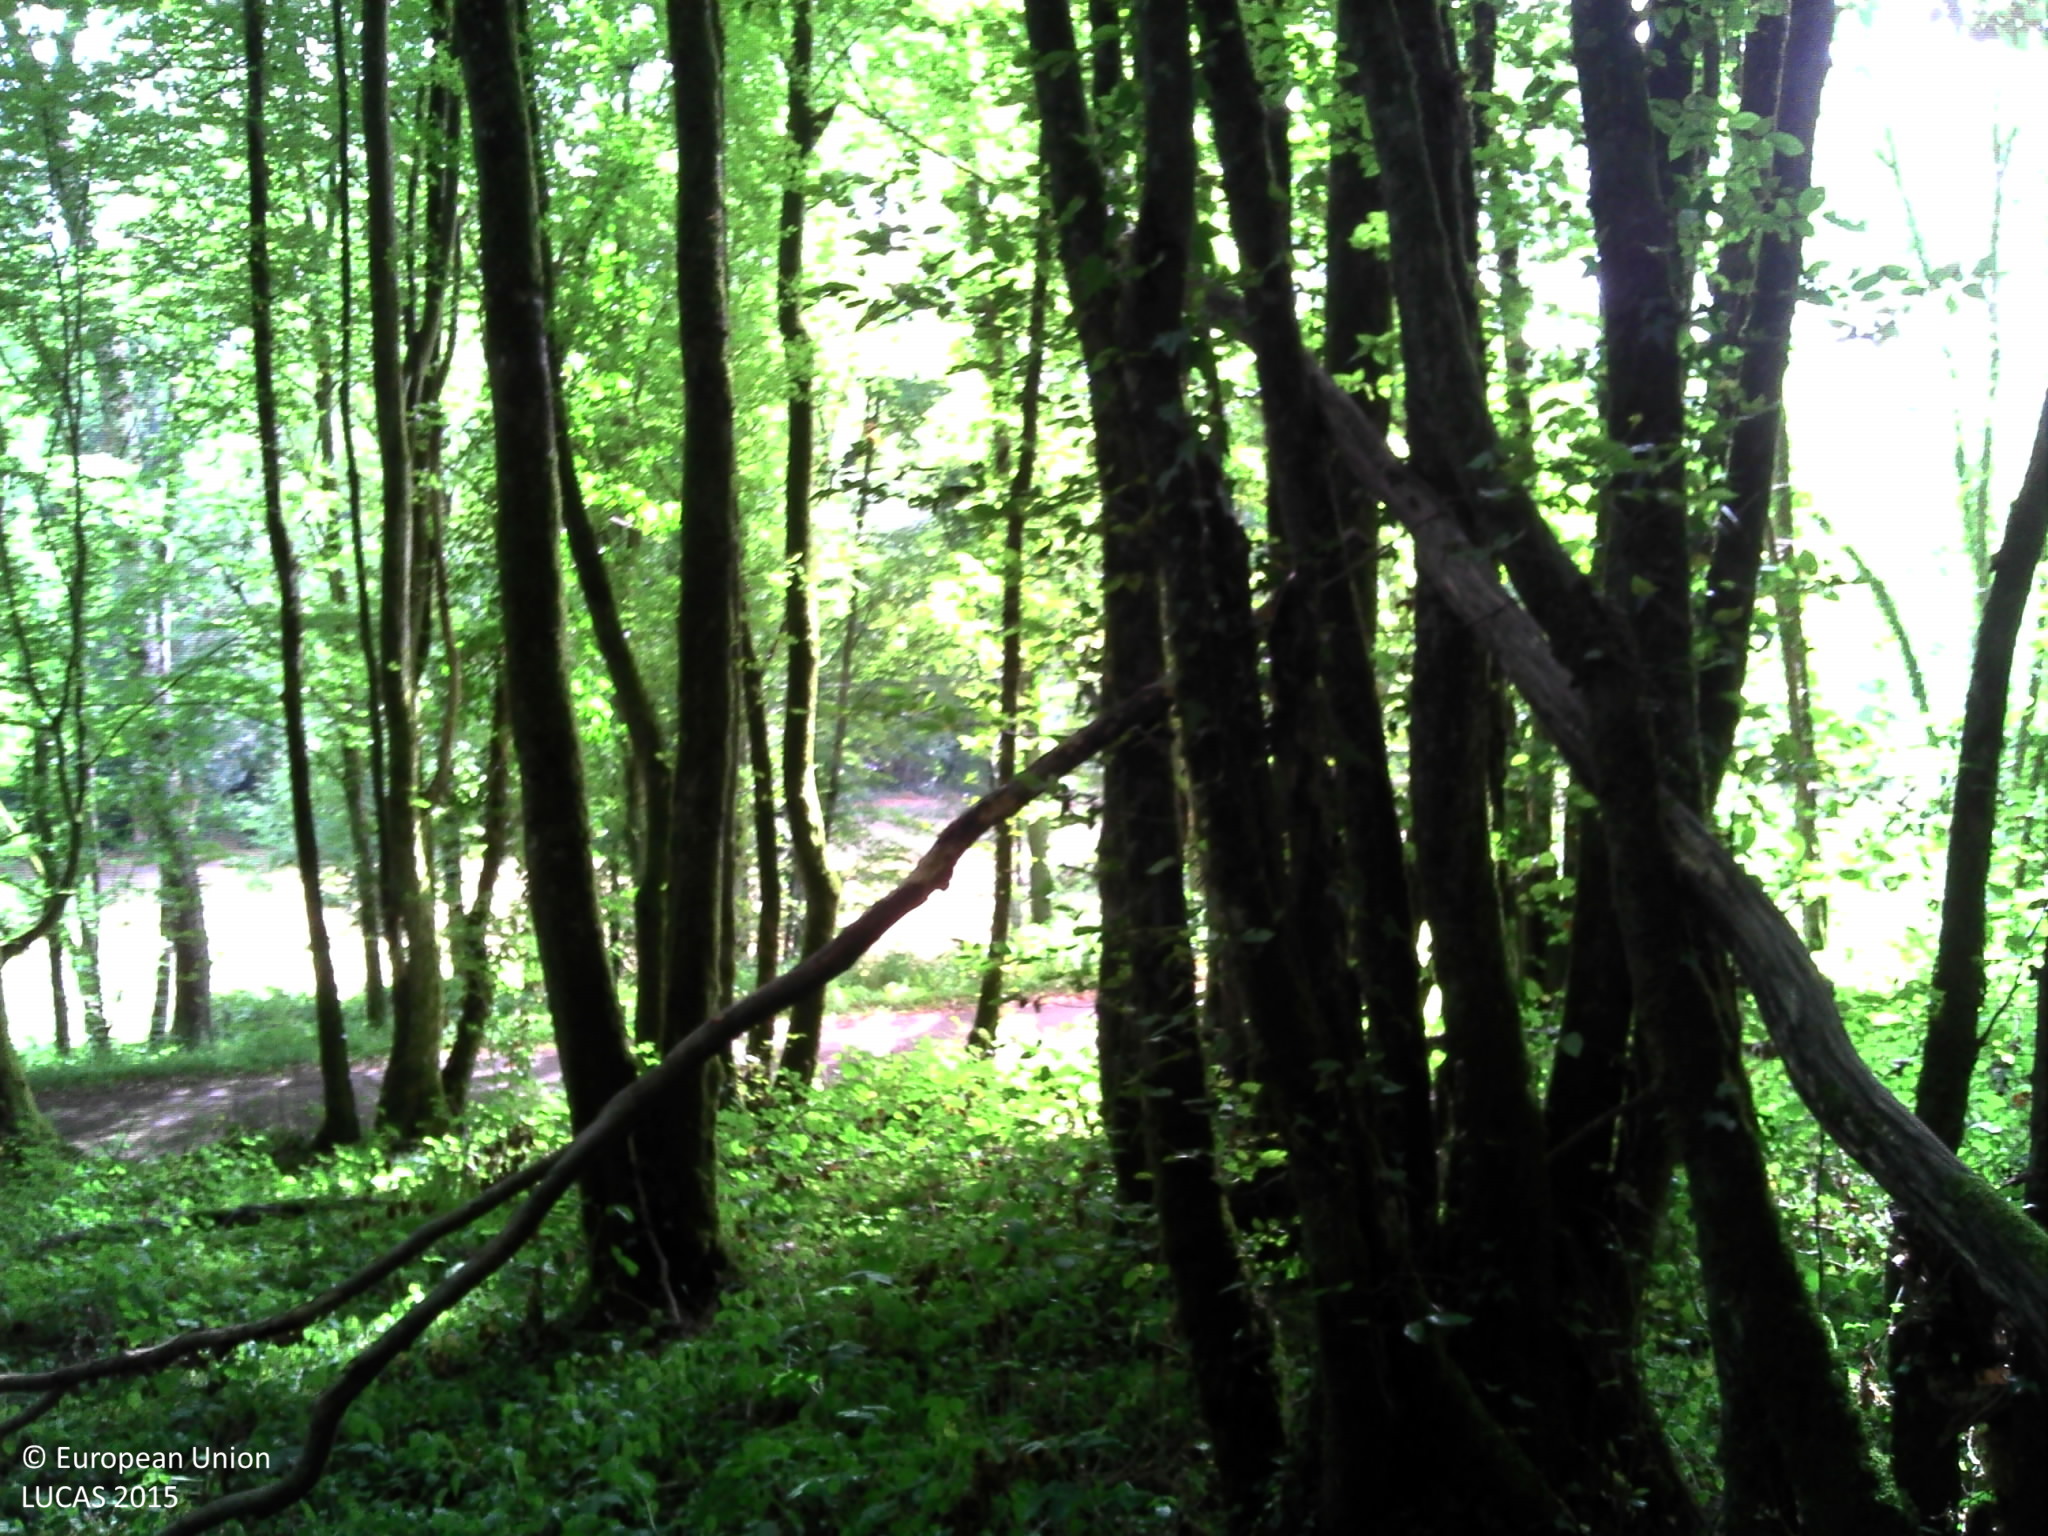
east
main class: Woodland
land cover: Broadleaved woodland
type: mesophytic deciduous forest
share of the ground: > 75 %
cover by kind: broadleaved forest trees 90 %, herbaceous plants 5 %, lichens and mosses 5 %
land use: Forestry
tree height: > 5 m
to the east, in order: Broadleaved woodland; Grass margins; Paved roads, cycling and walking lanes; Electric lines; Grass margins; Broadleaved woodland; Fences; Grassland with sparse tree/shrub cover; Fences; Lines of trees; Inland fresh running water; Broadleaved woodland; Grassland without tree/shrub cover
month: July
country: FR
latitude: 47.9154
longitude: 3.0756
